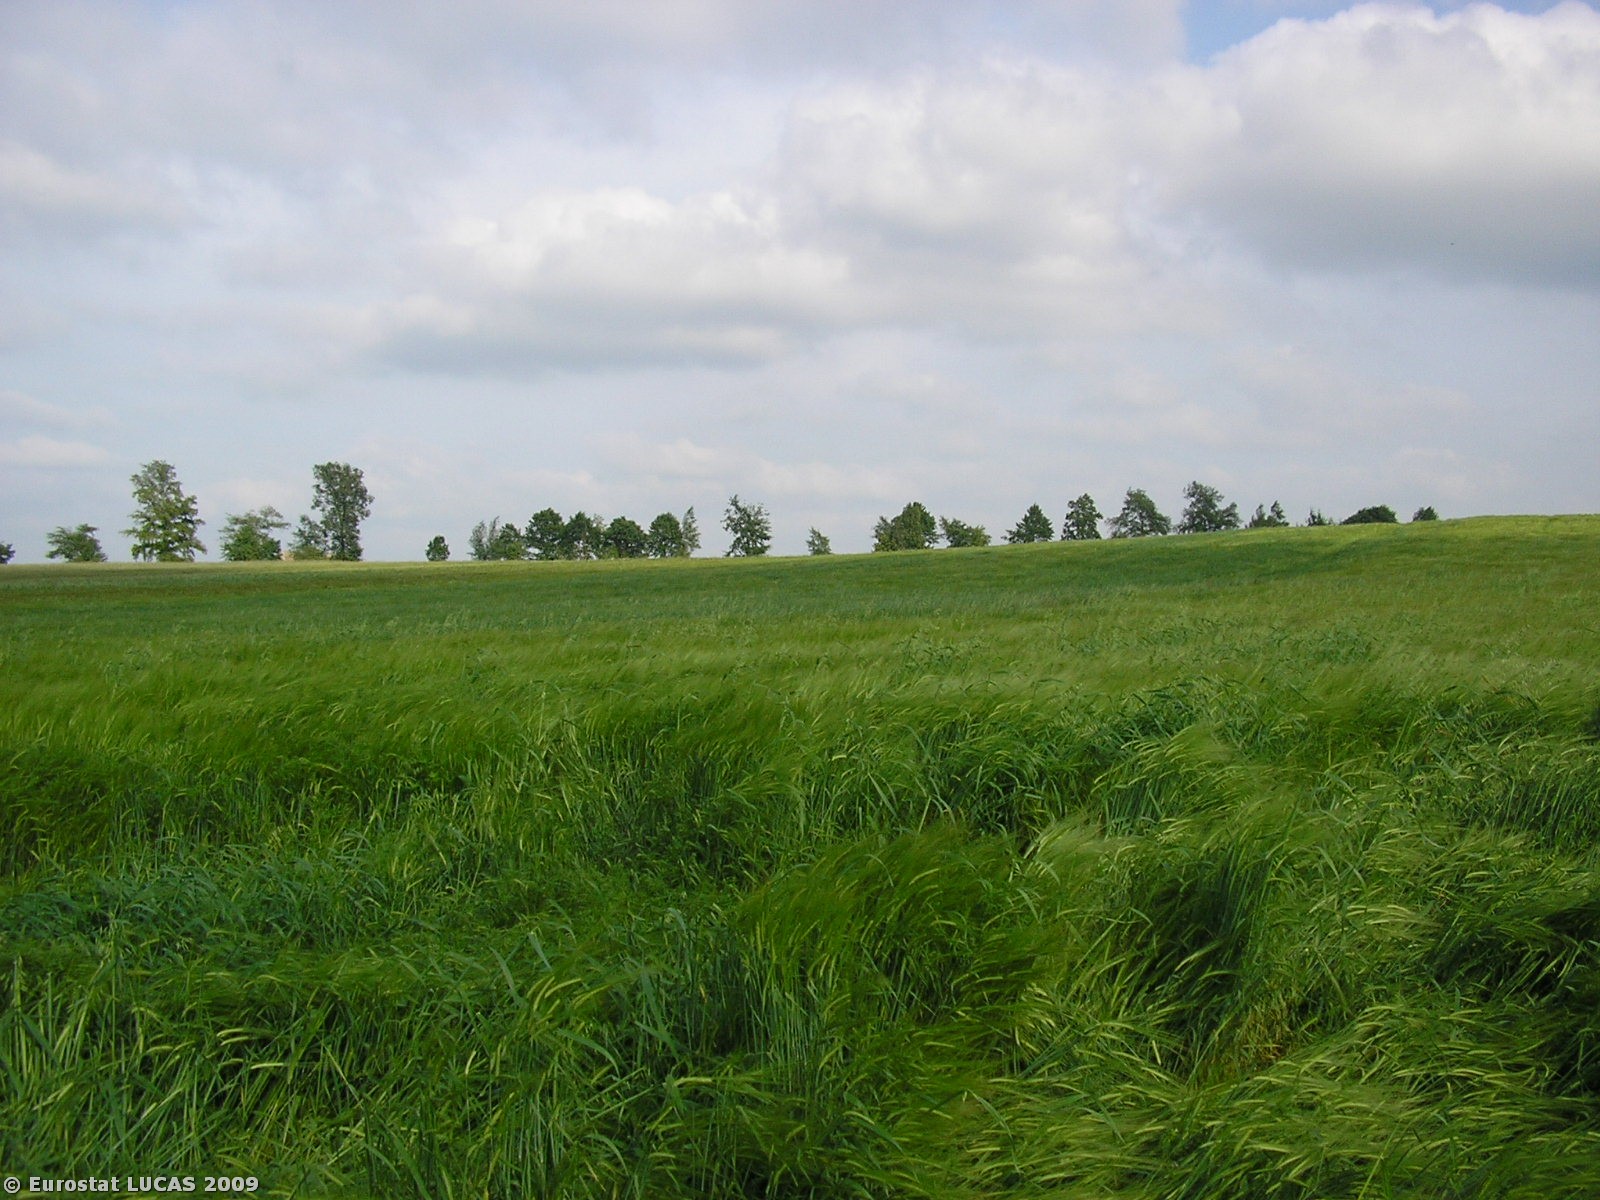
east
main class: Cropland
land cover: Barley
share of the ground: > 75 %
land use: Agriculture (excluding fallow land and kitchen gardens)
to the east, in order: Barley; Common wheat; Triticale
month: June
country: PL
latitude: 51.0853
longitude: 18.3986
